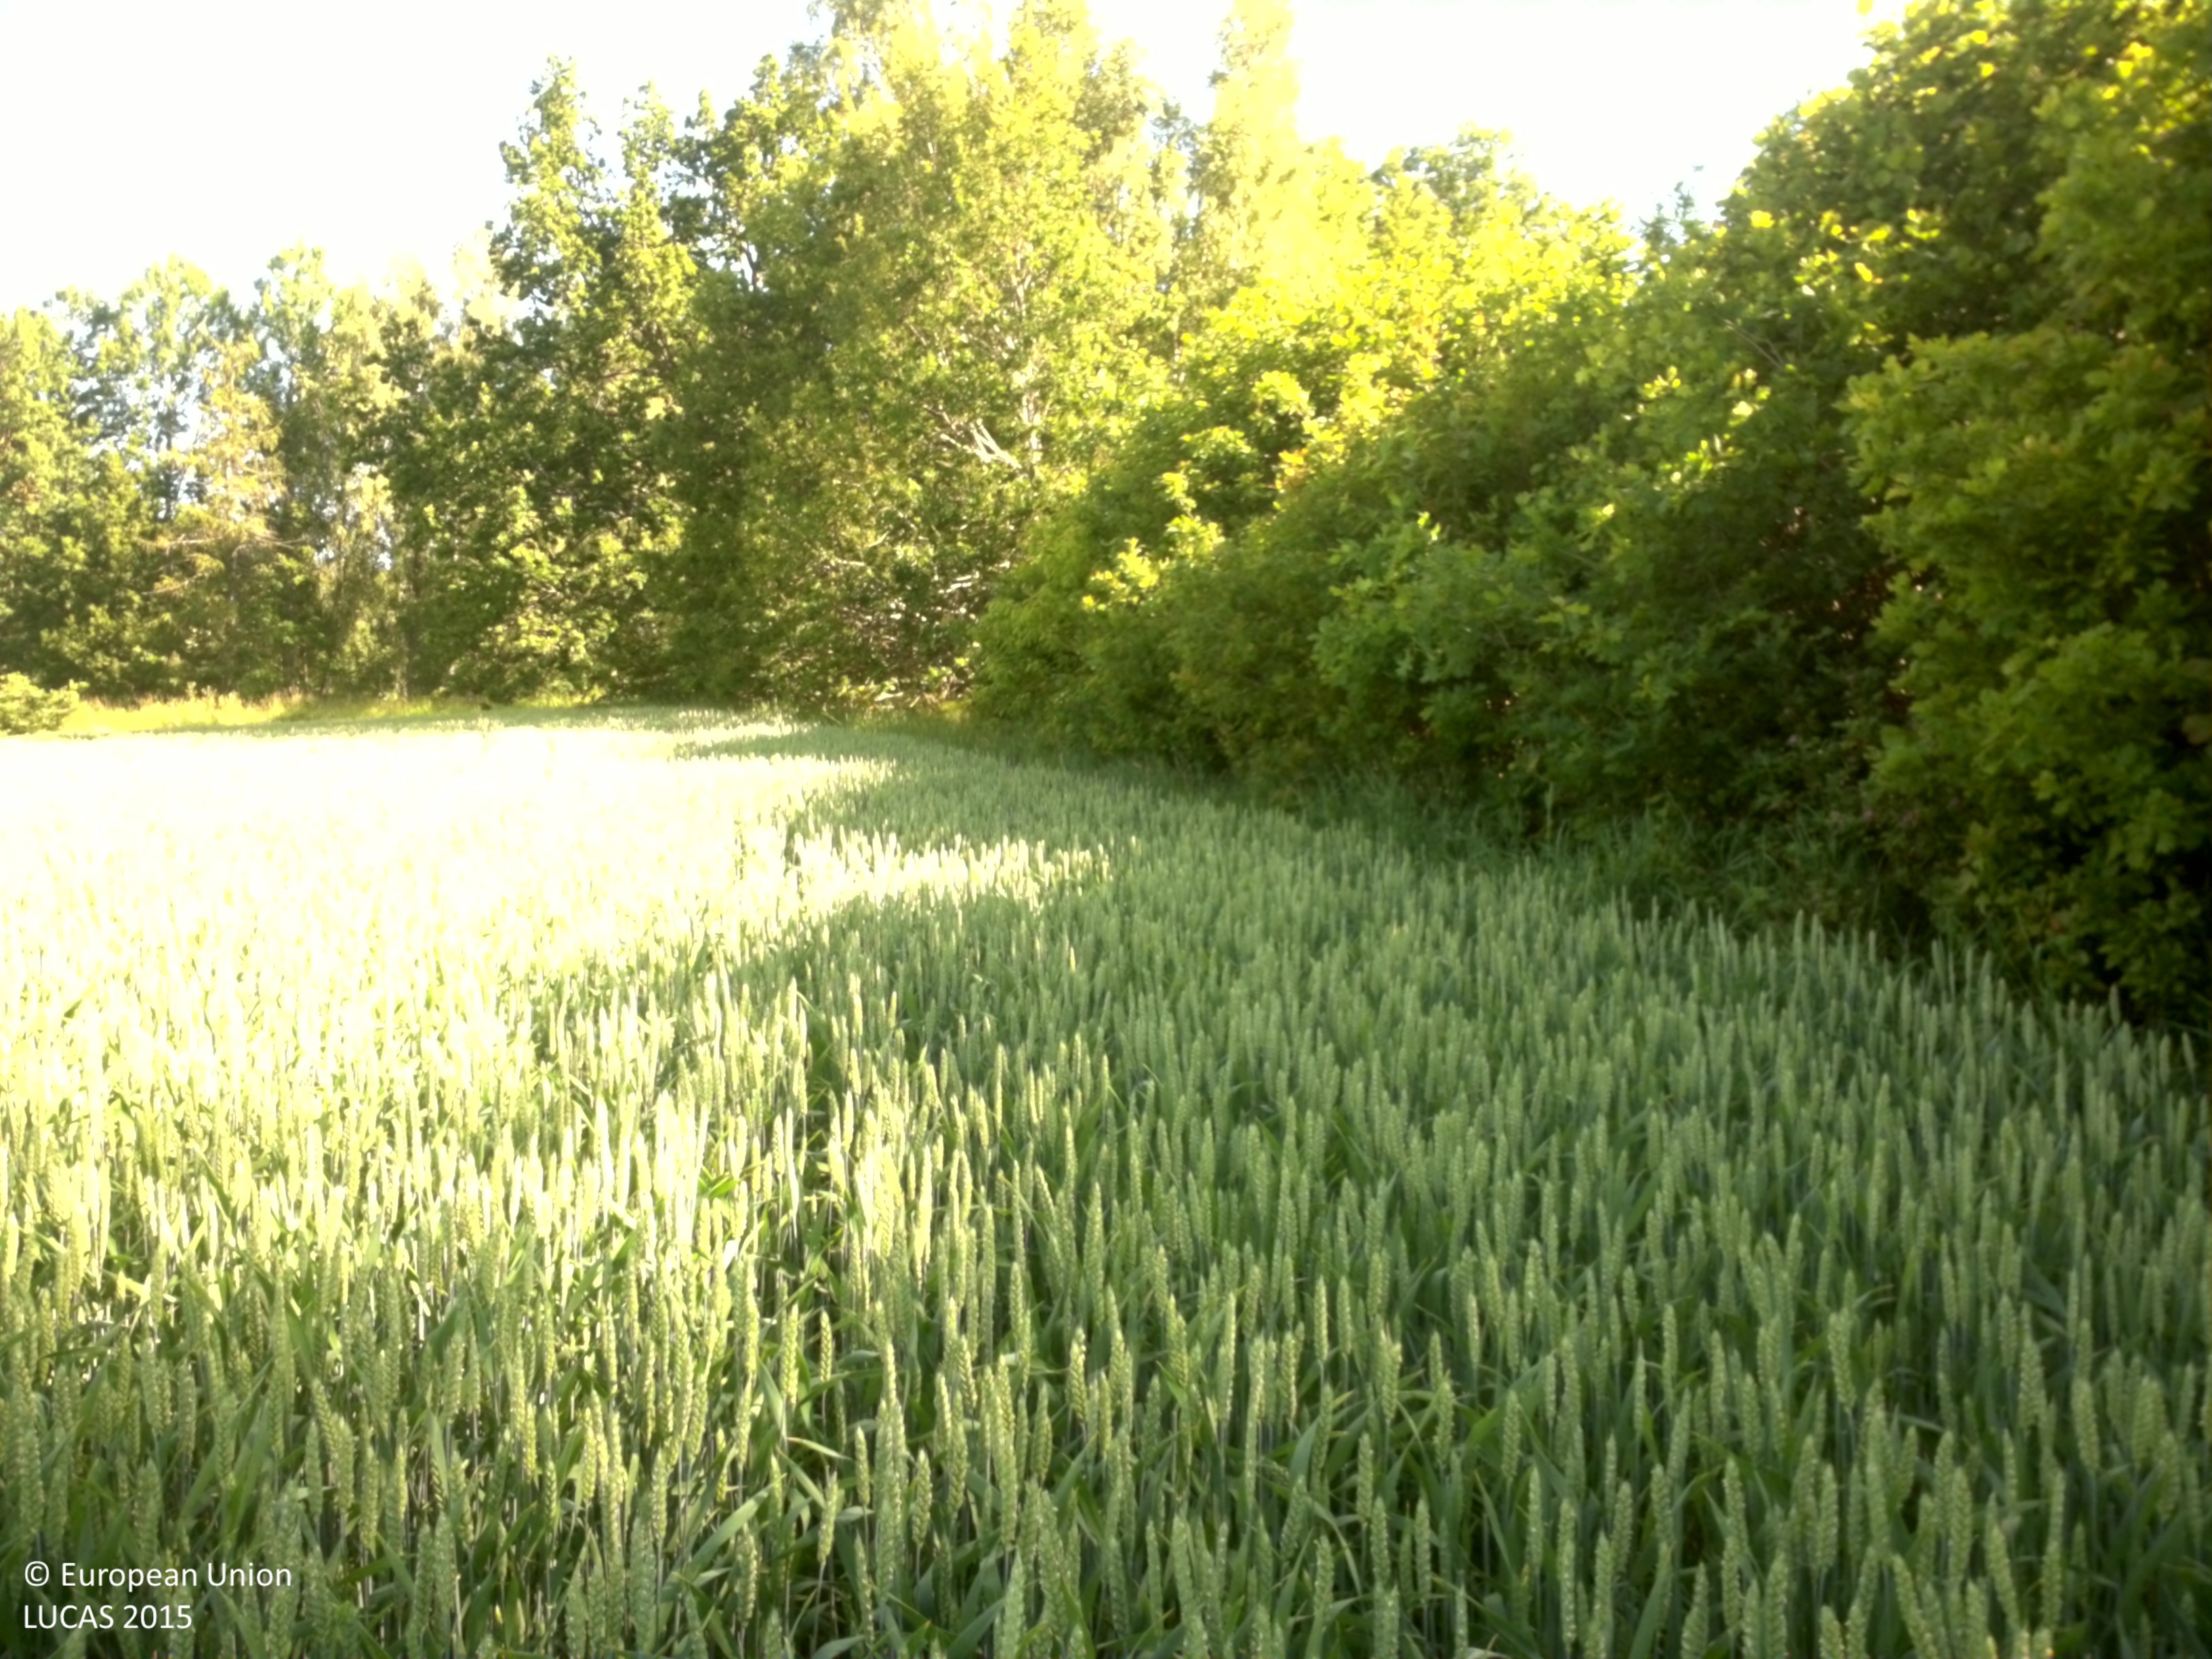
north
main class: Artificial land
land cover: Other artificial areas
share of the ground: > 75 %
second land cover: Common wheat
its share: > 75 %
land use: Electricity, gas and thermal power distribution
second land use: Agriculture (excluding fallow land and kitchen gardens)
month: June
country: SE
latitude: 58.5230
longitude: 15.4714
